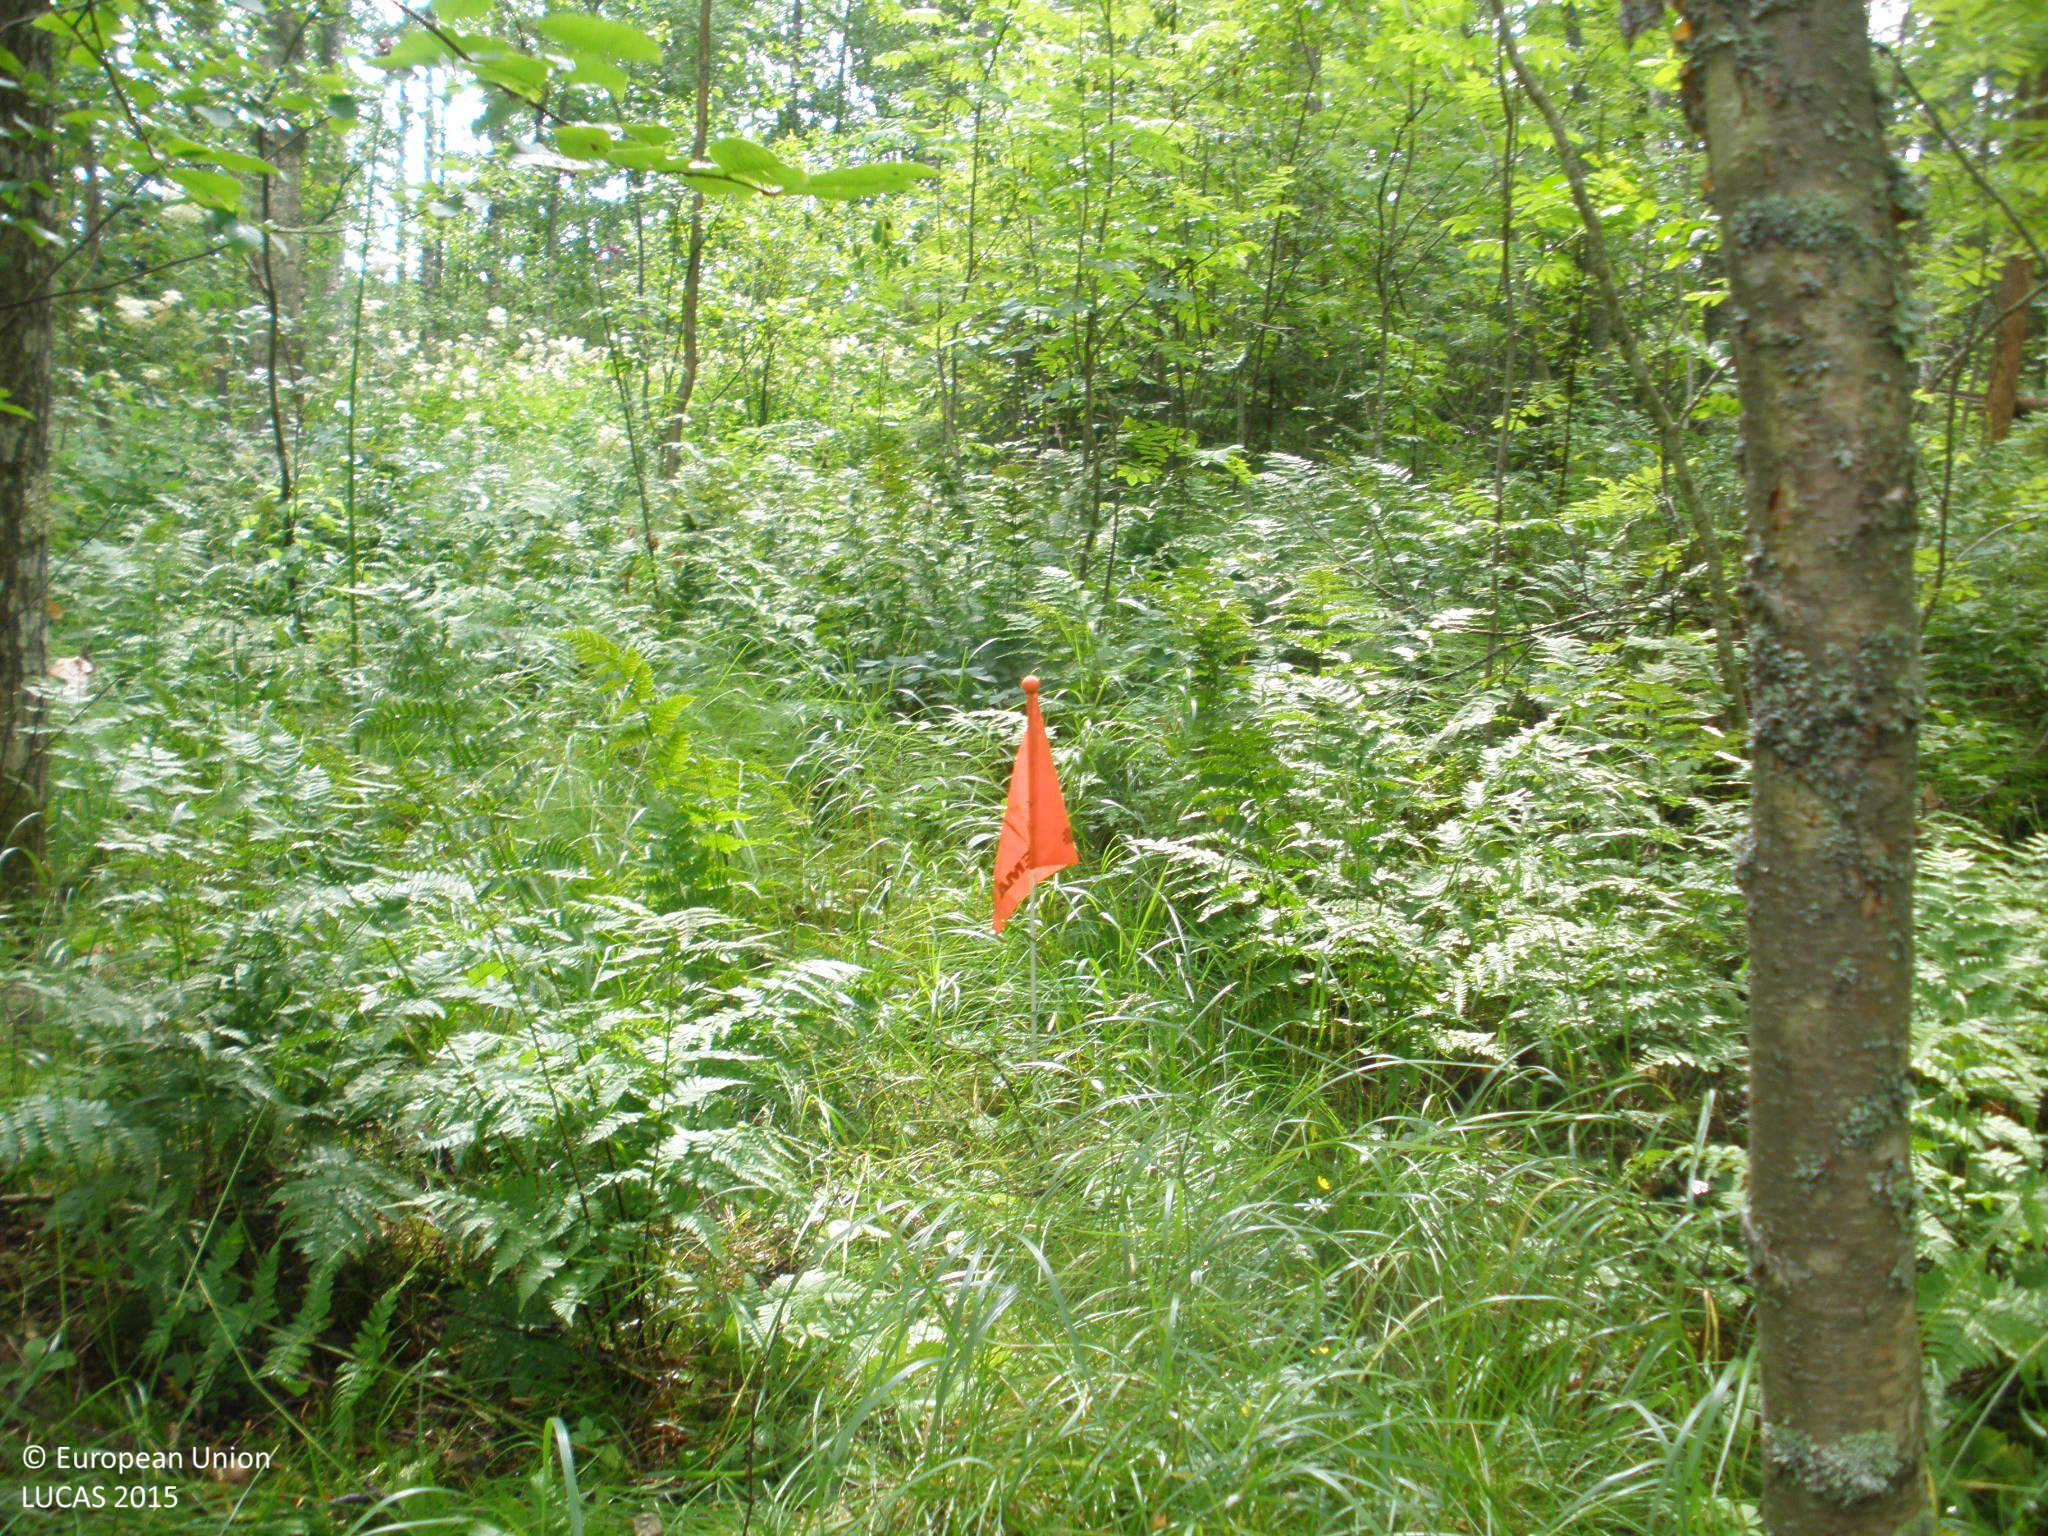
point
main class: Woodland
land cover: Broadleaved woodland
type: boreal forest
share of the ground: > 75 %
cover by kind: broadleaved forest trees 80 %, herbaceous plants 10 %, coniferous forest trees 5 %, shrubs 5 %
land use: Forestry
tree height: > 5 m
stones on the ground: 10 - 25 %
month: July
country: FI
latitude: 61.3298
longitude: 24.7351
